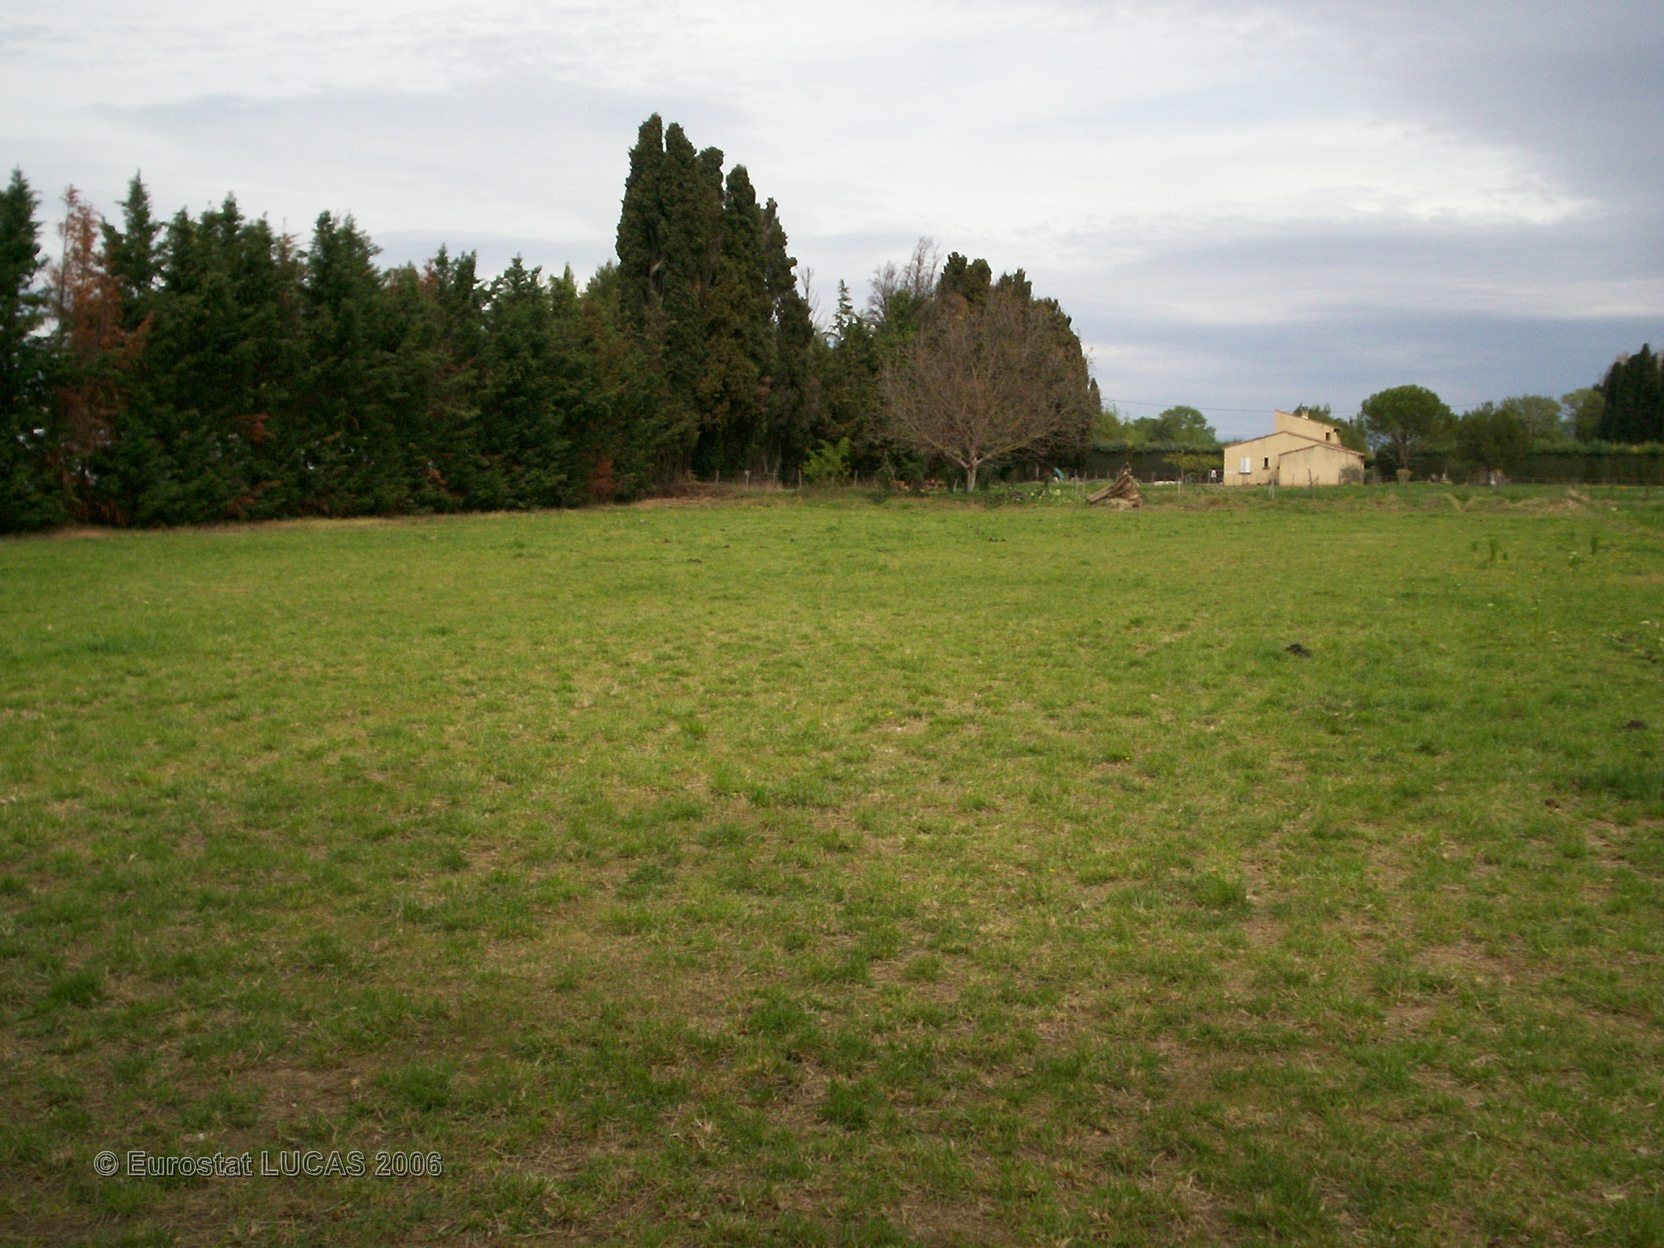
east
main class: Grassland
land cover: Grassland with sparse tree/shrub cover
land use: Residential
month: April
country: FR
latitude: 43.8144
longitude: 4.9988
